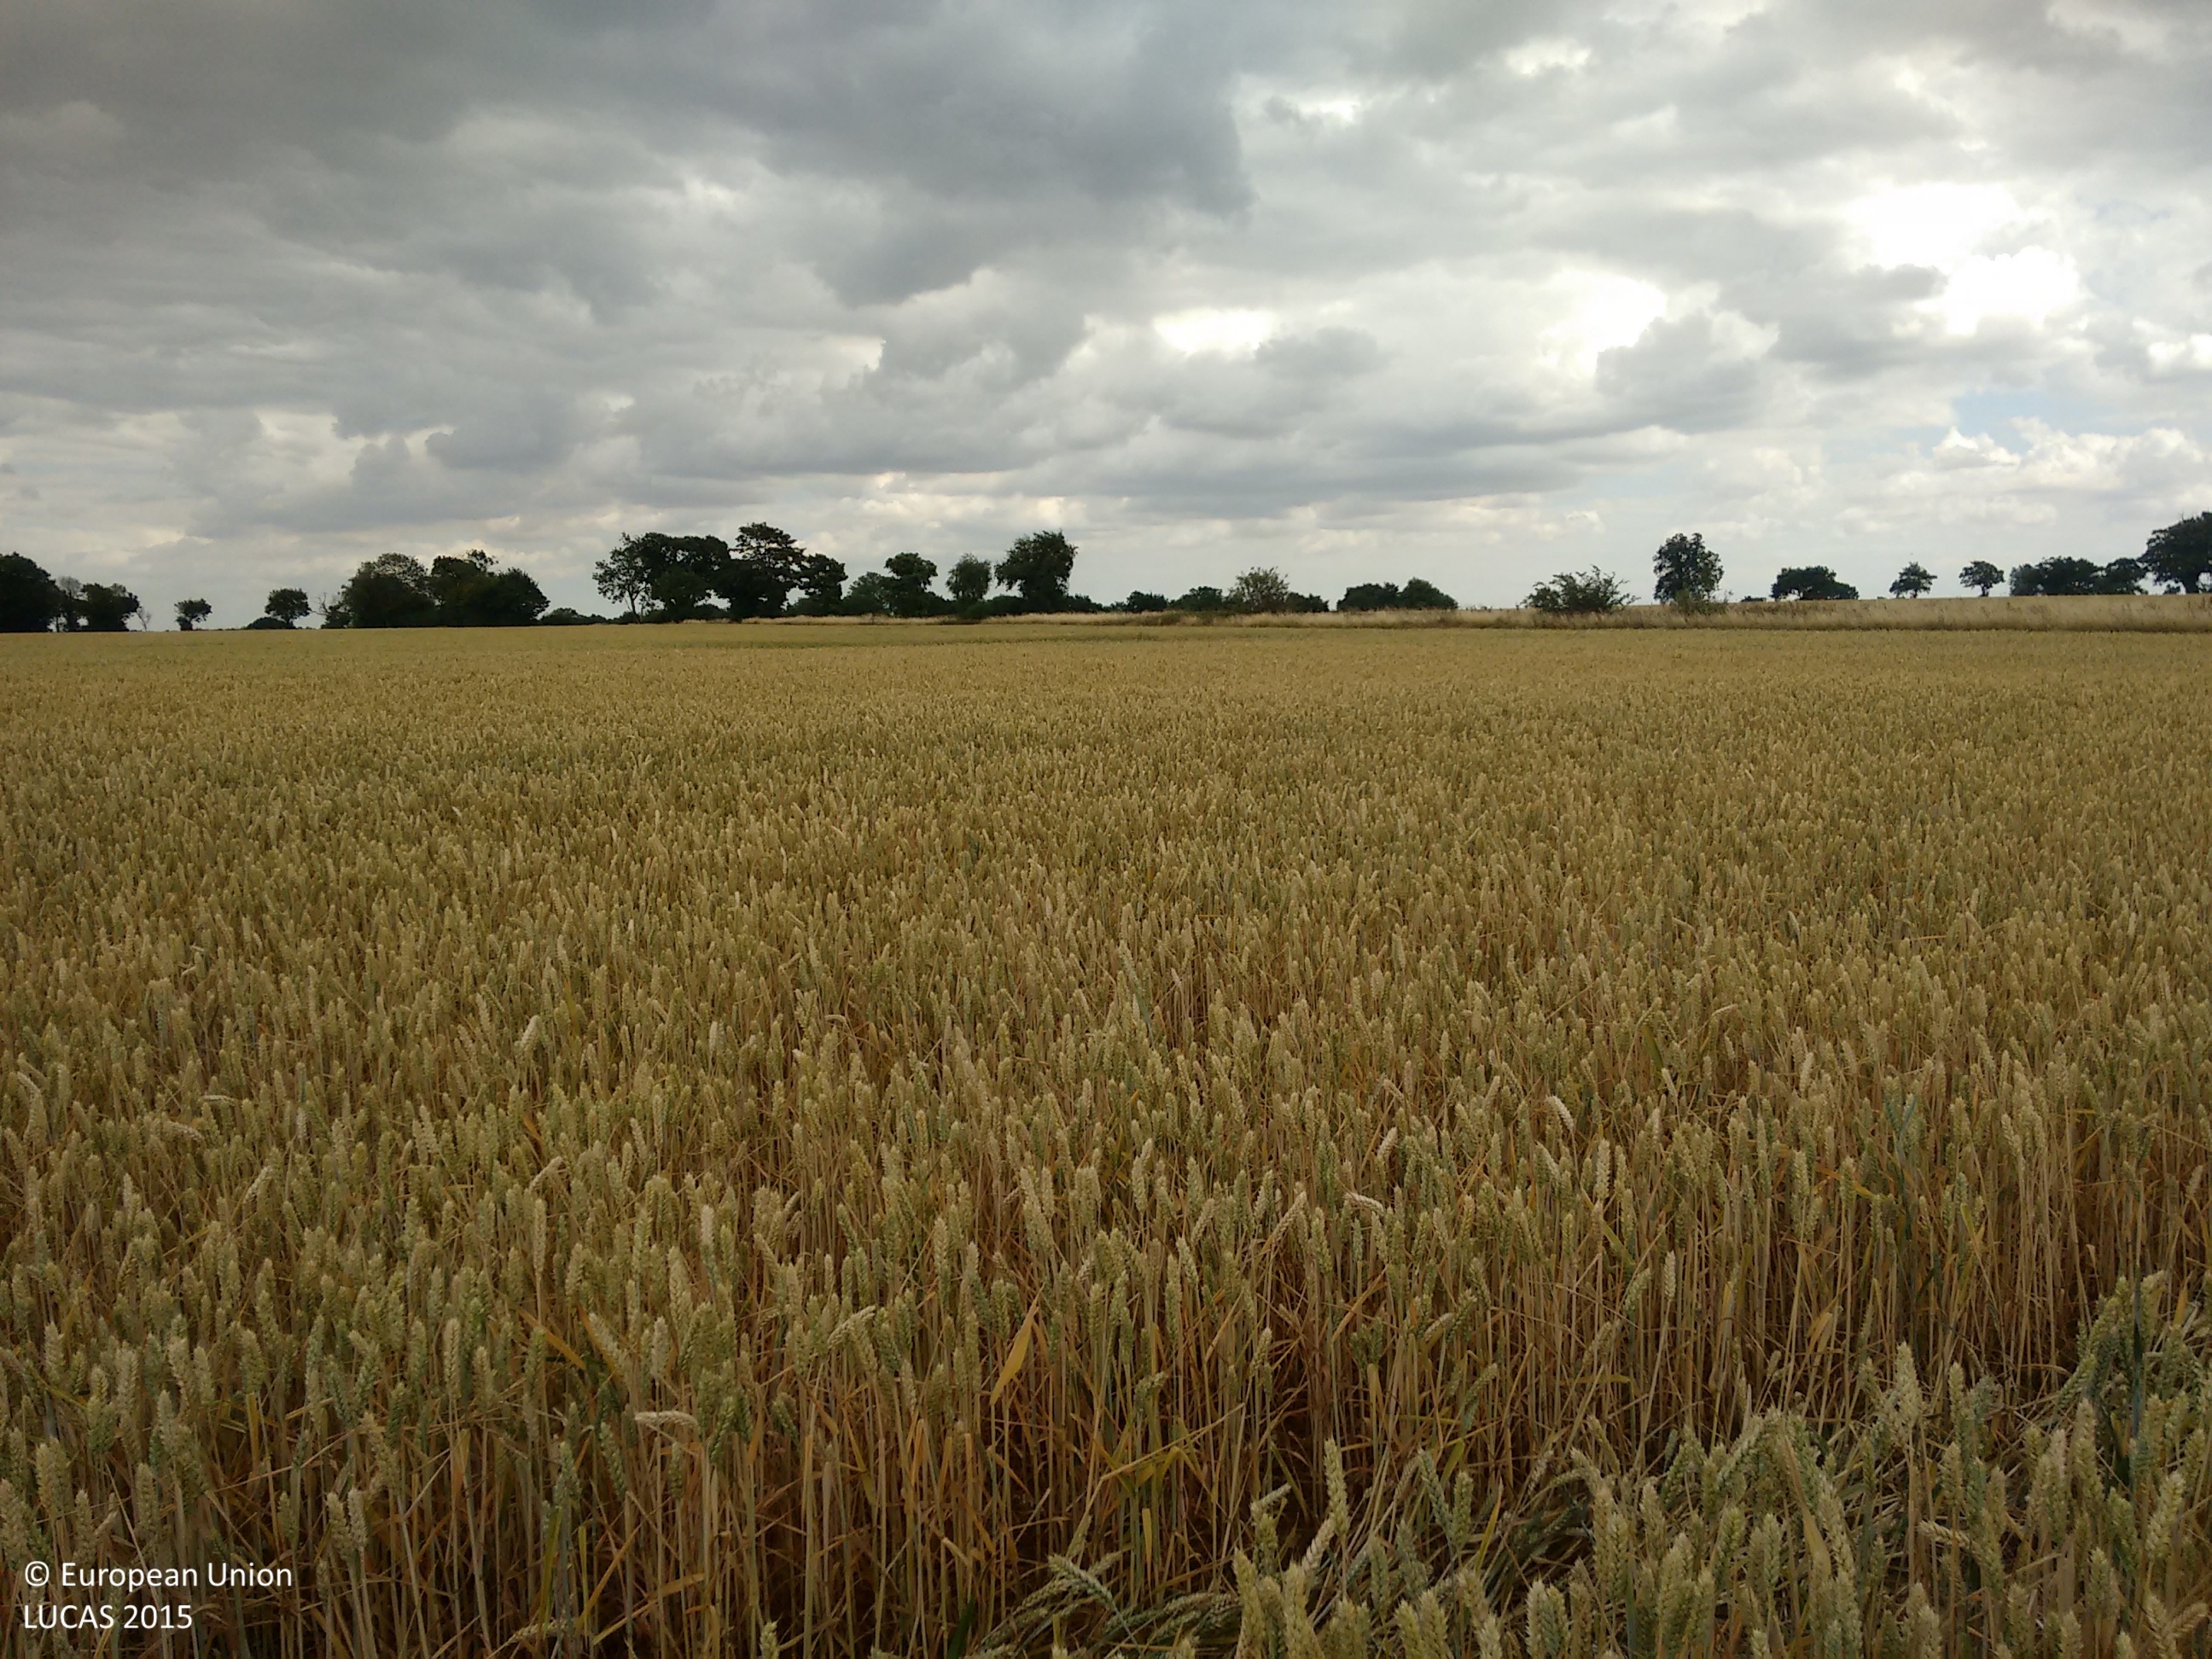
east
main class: Cropland
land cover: Common wheat
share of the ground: > 75 %
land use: Agriculture (excluding fallow land and kitchen gardens)
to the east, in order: Common wheat; Grass margins; Ditches and canals; Single bushes/trees; Grass margins; Common wheat
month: July
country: GB
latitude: 51.8038
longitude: 0.5900
